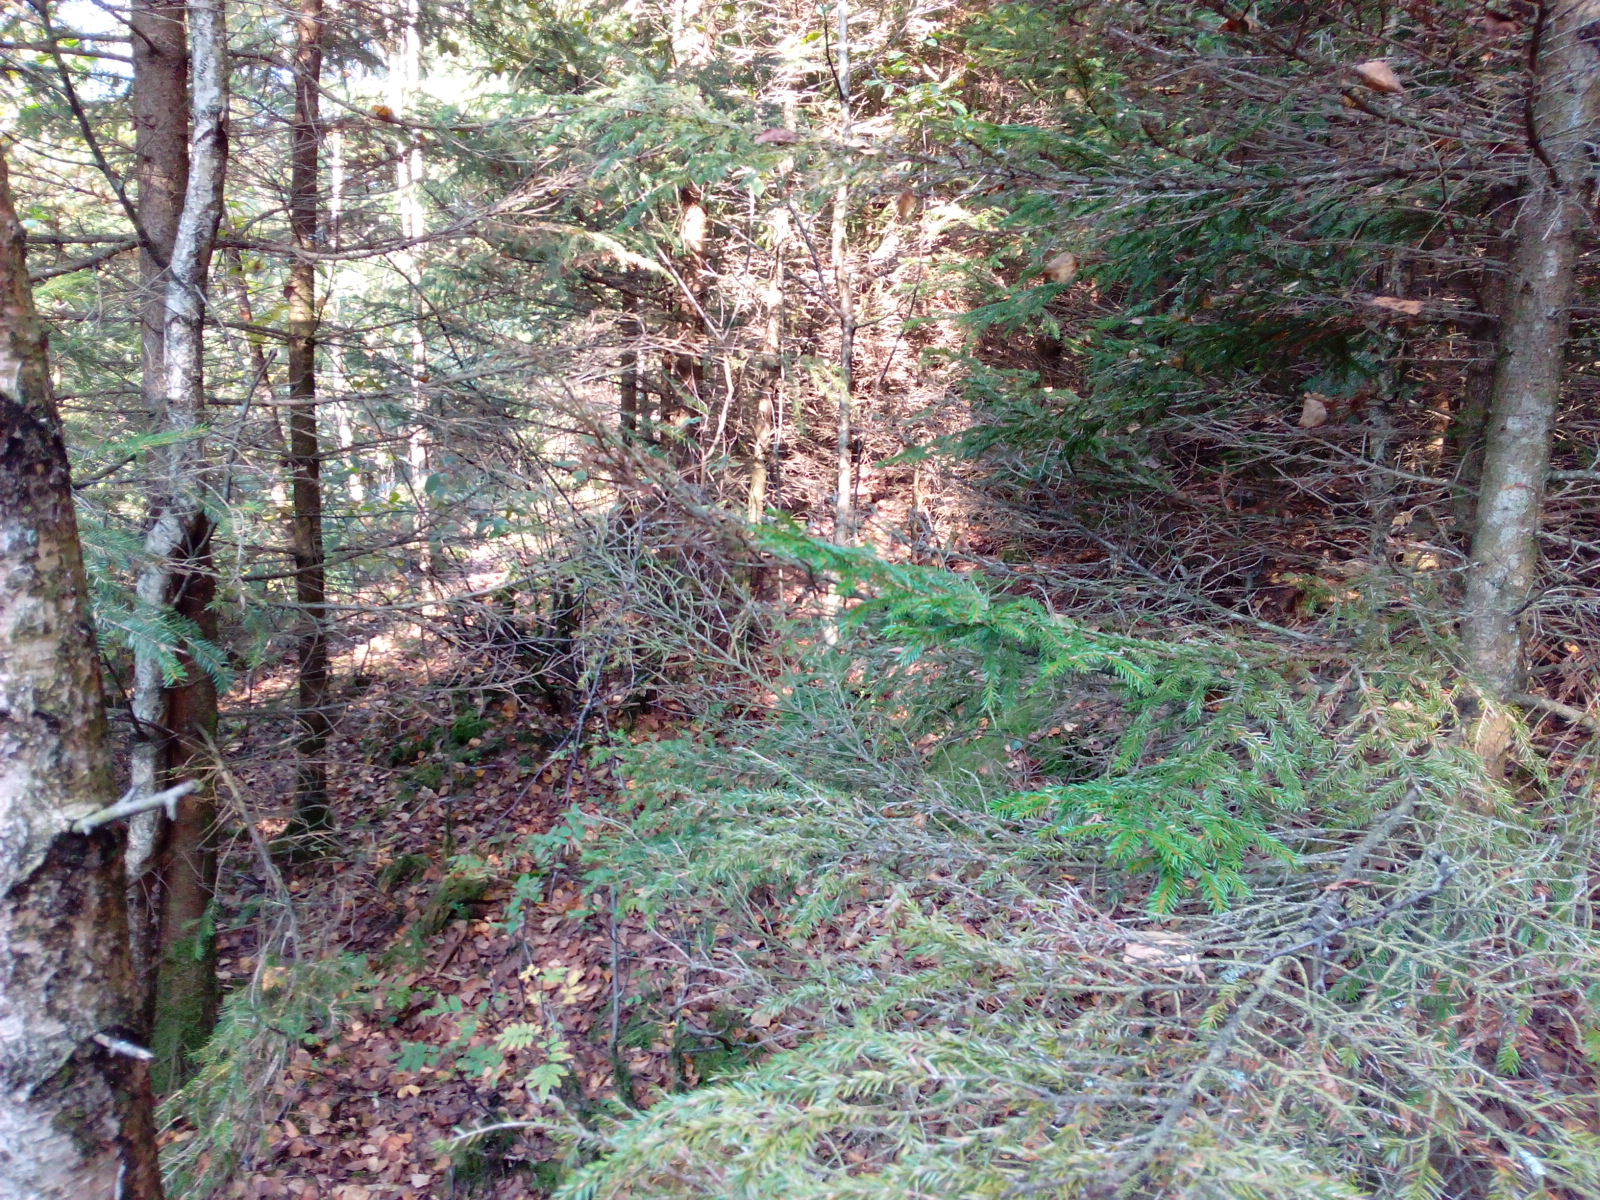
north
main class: Woodland
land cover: Other mixed woodland
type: hemiboreal forest and nemoral coniferous forest and mixed broadleaved-coniferous forest
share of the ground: > 75 %
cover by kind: coniferous forest trees 45 %, broadleaved forest trees 45 %, lichens and mosses 10 %
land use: Forestry
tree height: > 5 m
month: October
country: SE
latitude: 56.6000
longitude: 13.1080
